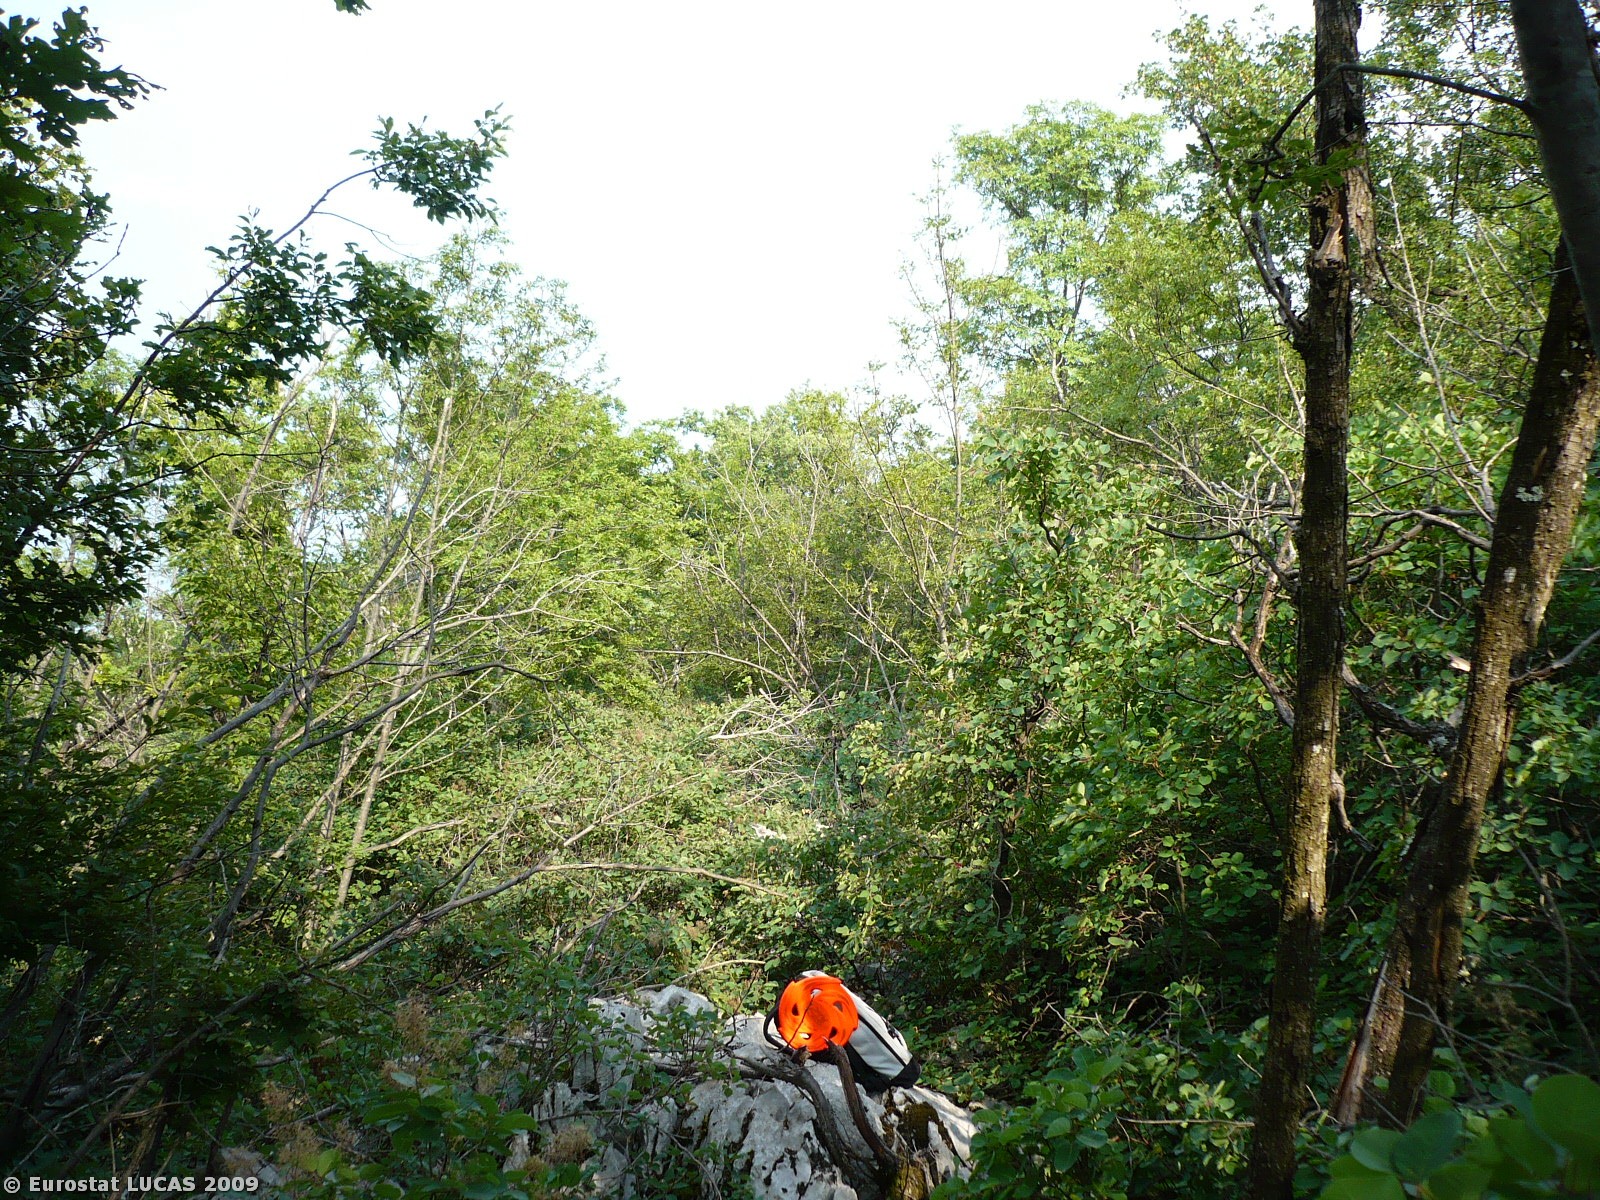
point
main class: Woodland
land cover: Broadleaved woodland
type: thermophilous deciduous forest
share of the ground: > 75 %
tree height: > 5 m
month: July
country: SI
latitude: 45.8016
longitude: 13.6628
